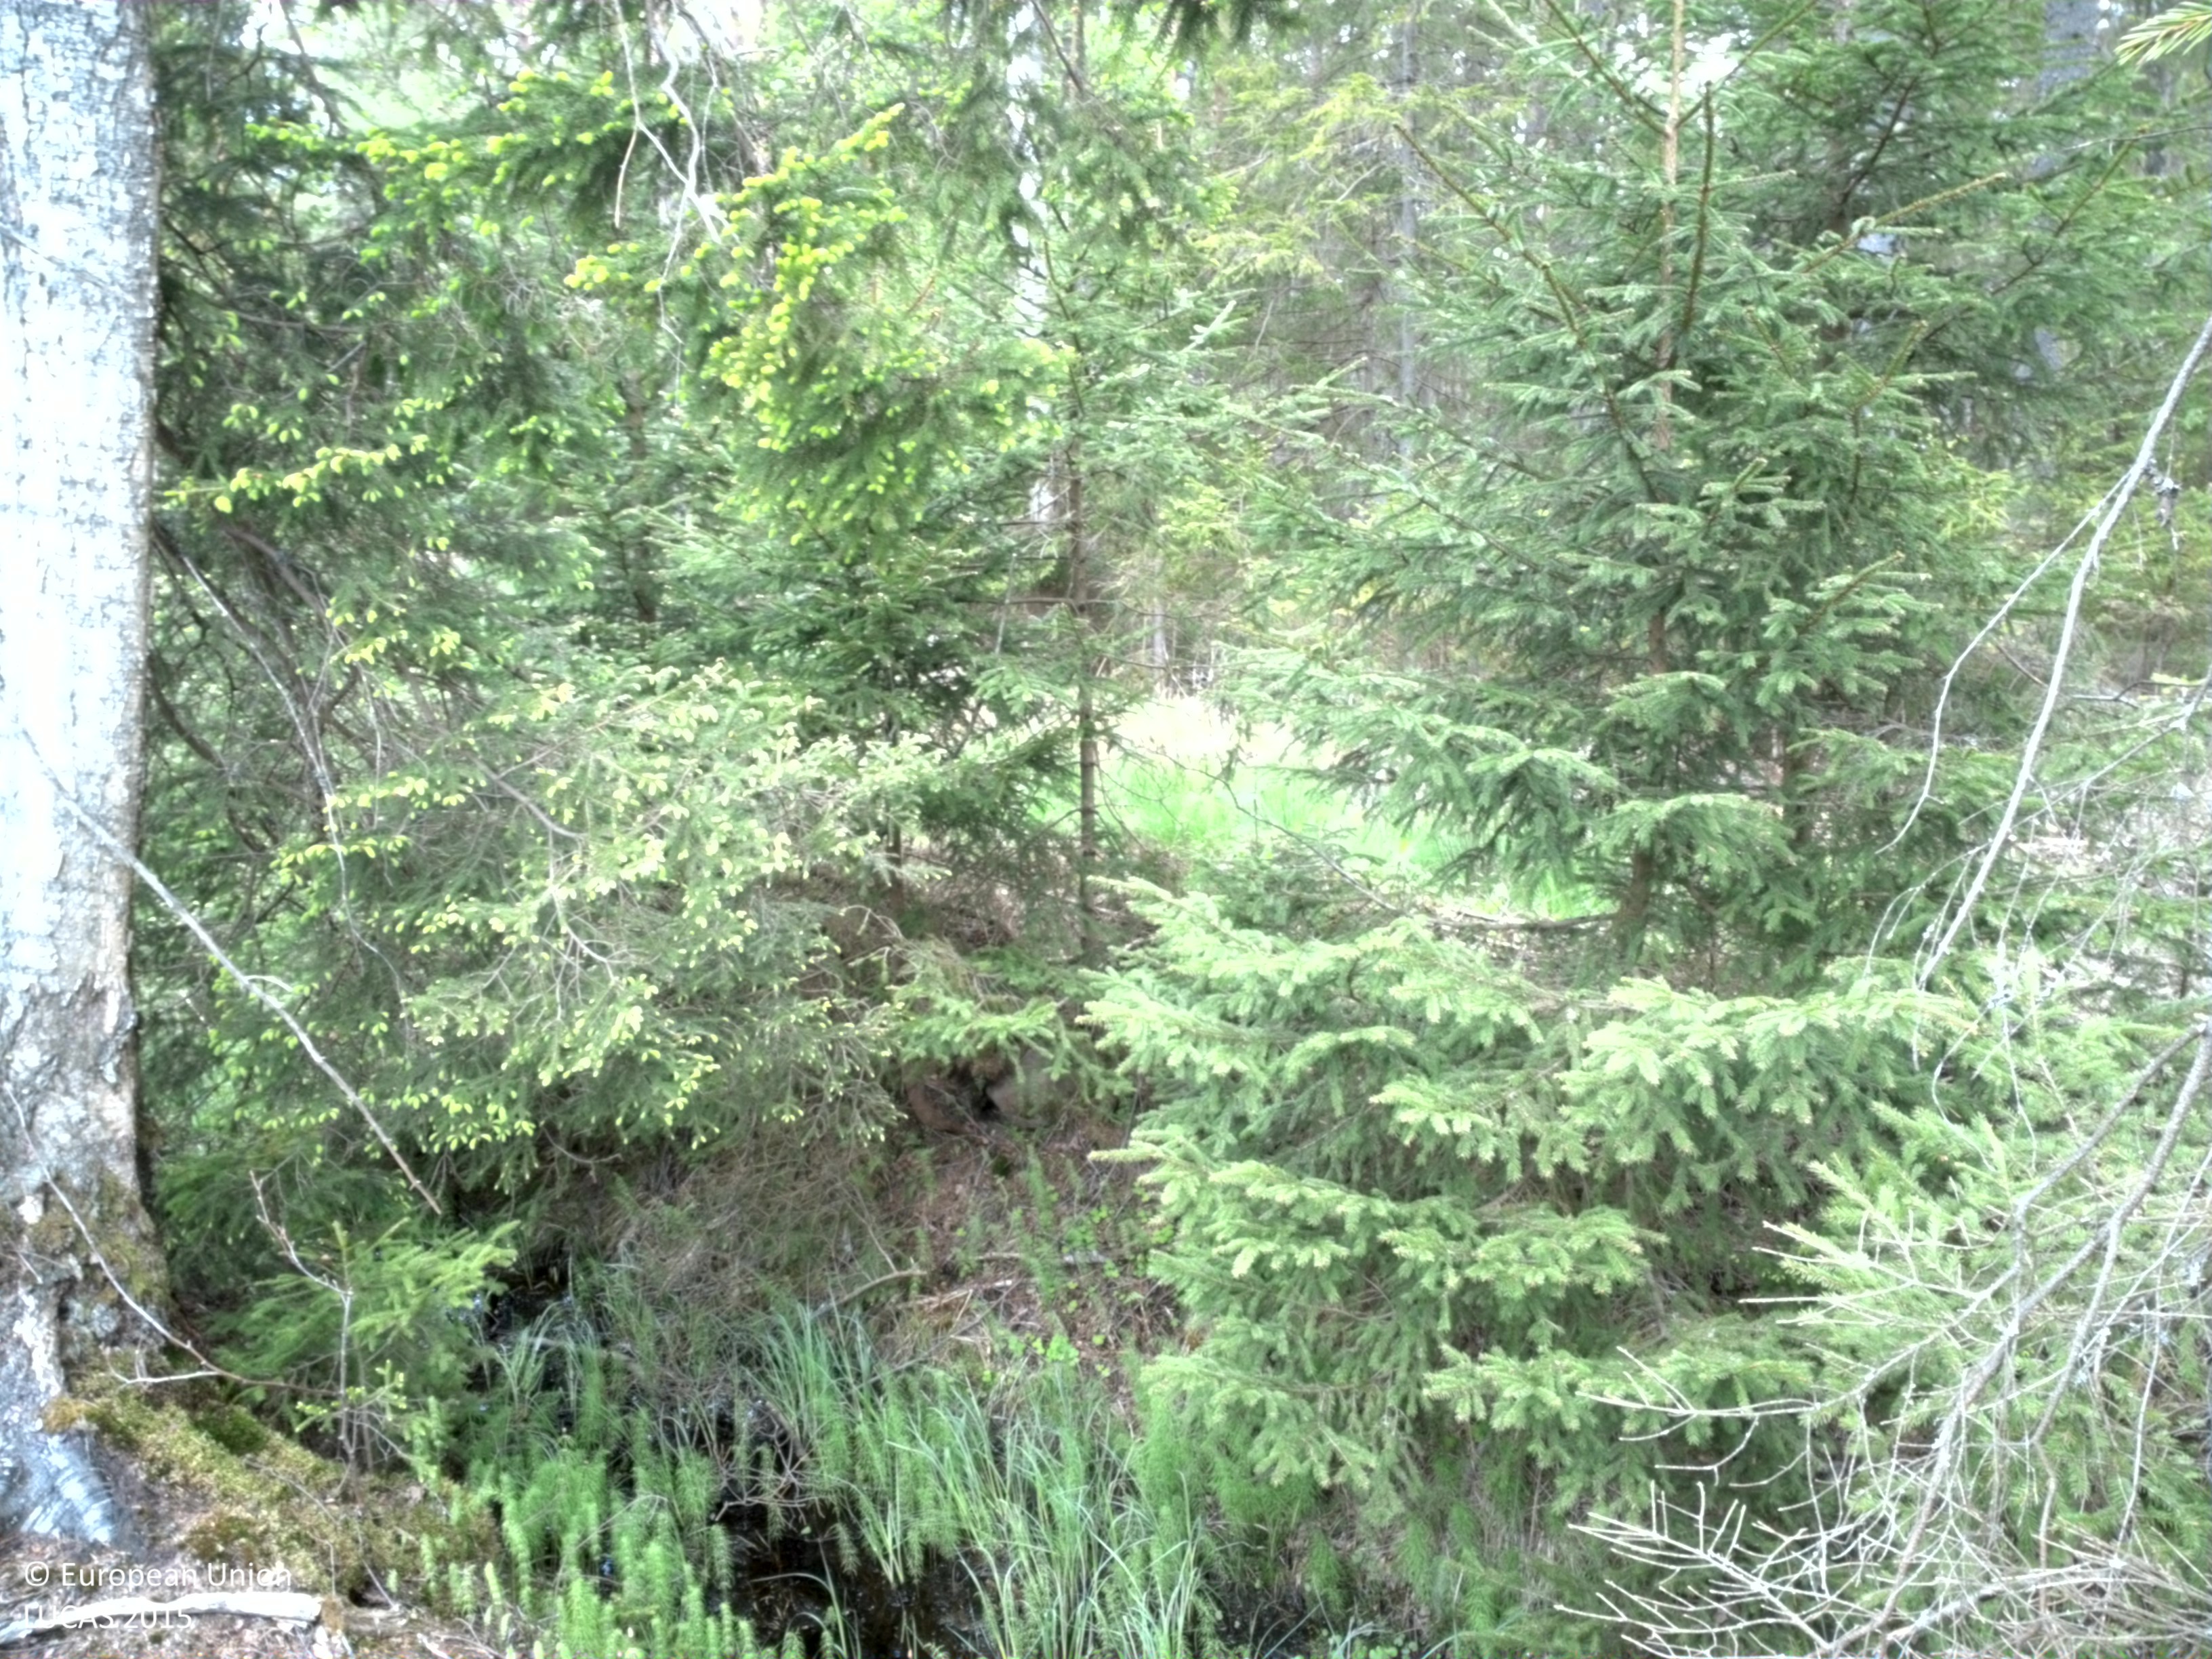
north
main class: Woodland
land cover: Spruce dominated mixed woodland
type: boreal forest
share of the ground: 25 - 50 %
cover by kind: coniferous forest trees 30 %, herbaceous plants 20 %, unconsolidated bare surface 15 %, broadleaved forest trees 10 %, shrubs 10 %, lichens and mosses 10 %, consolidated bare surface 5 %
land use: Forestry
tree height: > 5 m
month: May
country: SE
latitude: 56.6563
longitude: 15.2672
